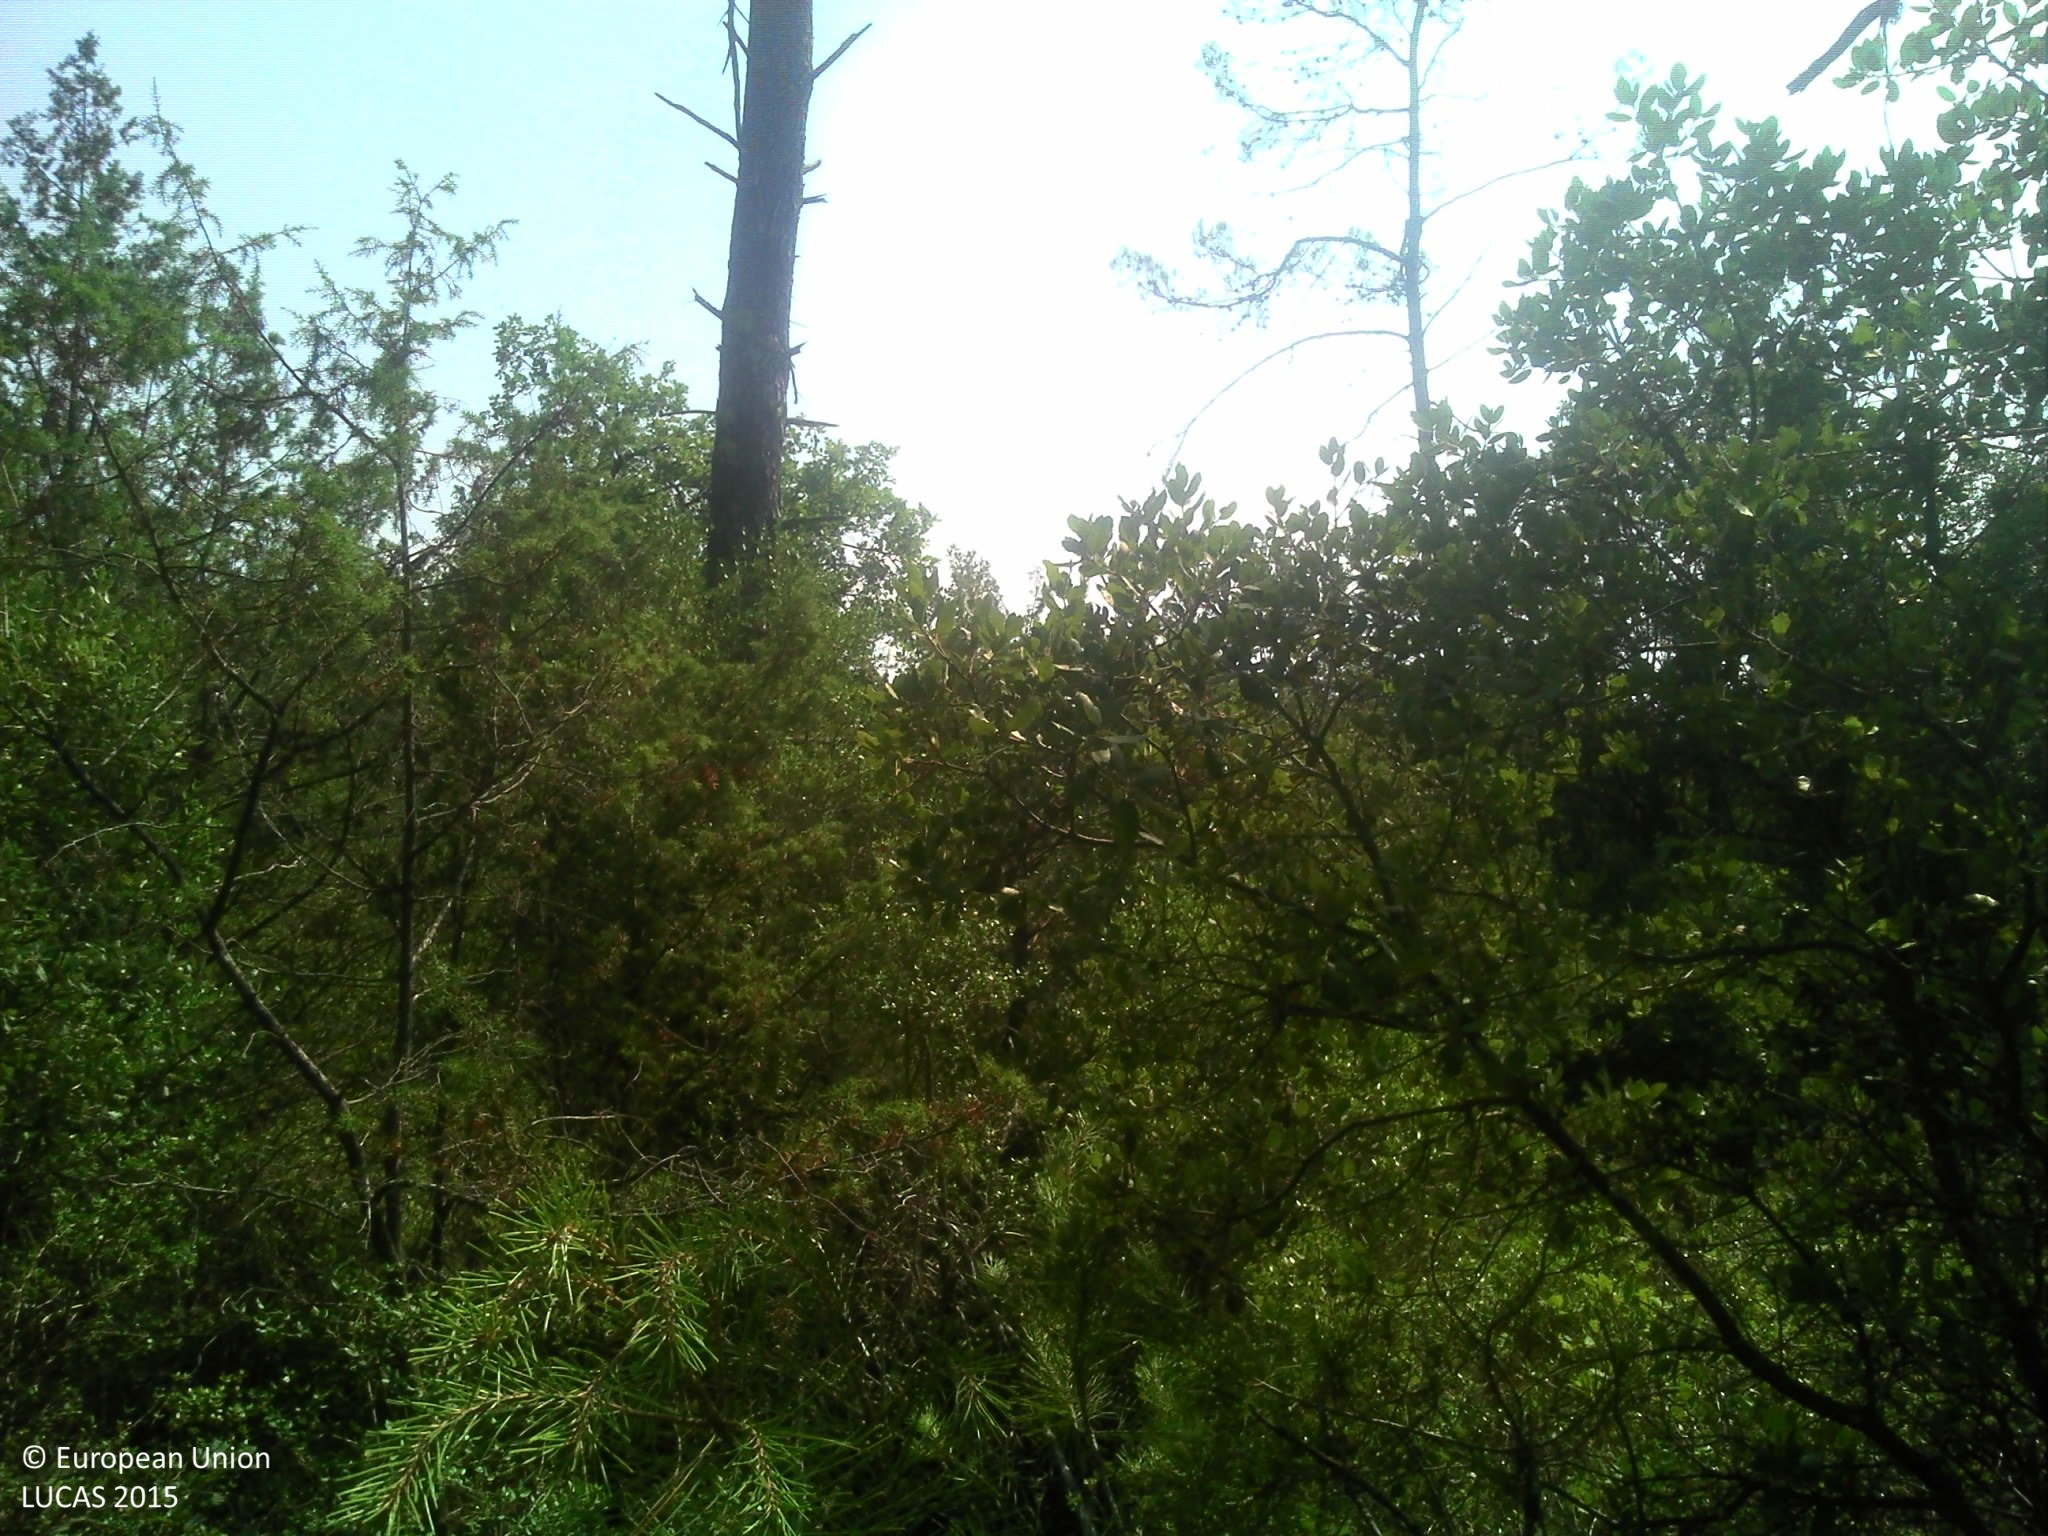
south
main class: Woodland
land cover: Pine dominated mixed woodland
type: coniferous forest of the mediterranean region
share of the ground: > 75 %
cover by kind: broadleaved forest trees 40 %, coniferous forest trees 35 %, shrubs 20 %, herbaceous plants 5 %
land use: Semi-natural and natural areas not in use
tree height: > 5 m
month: July
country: FR
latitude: 43.4561
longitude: 6.3630
